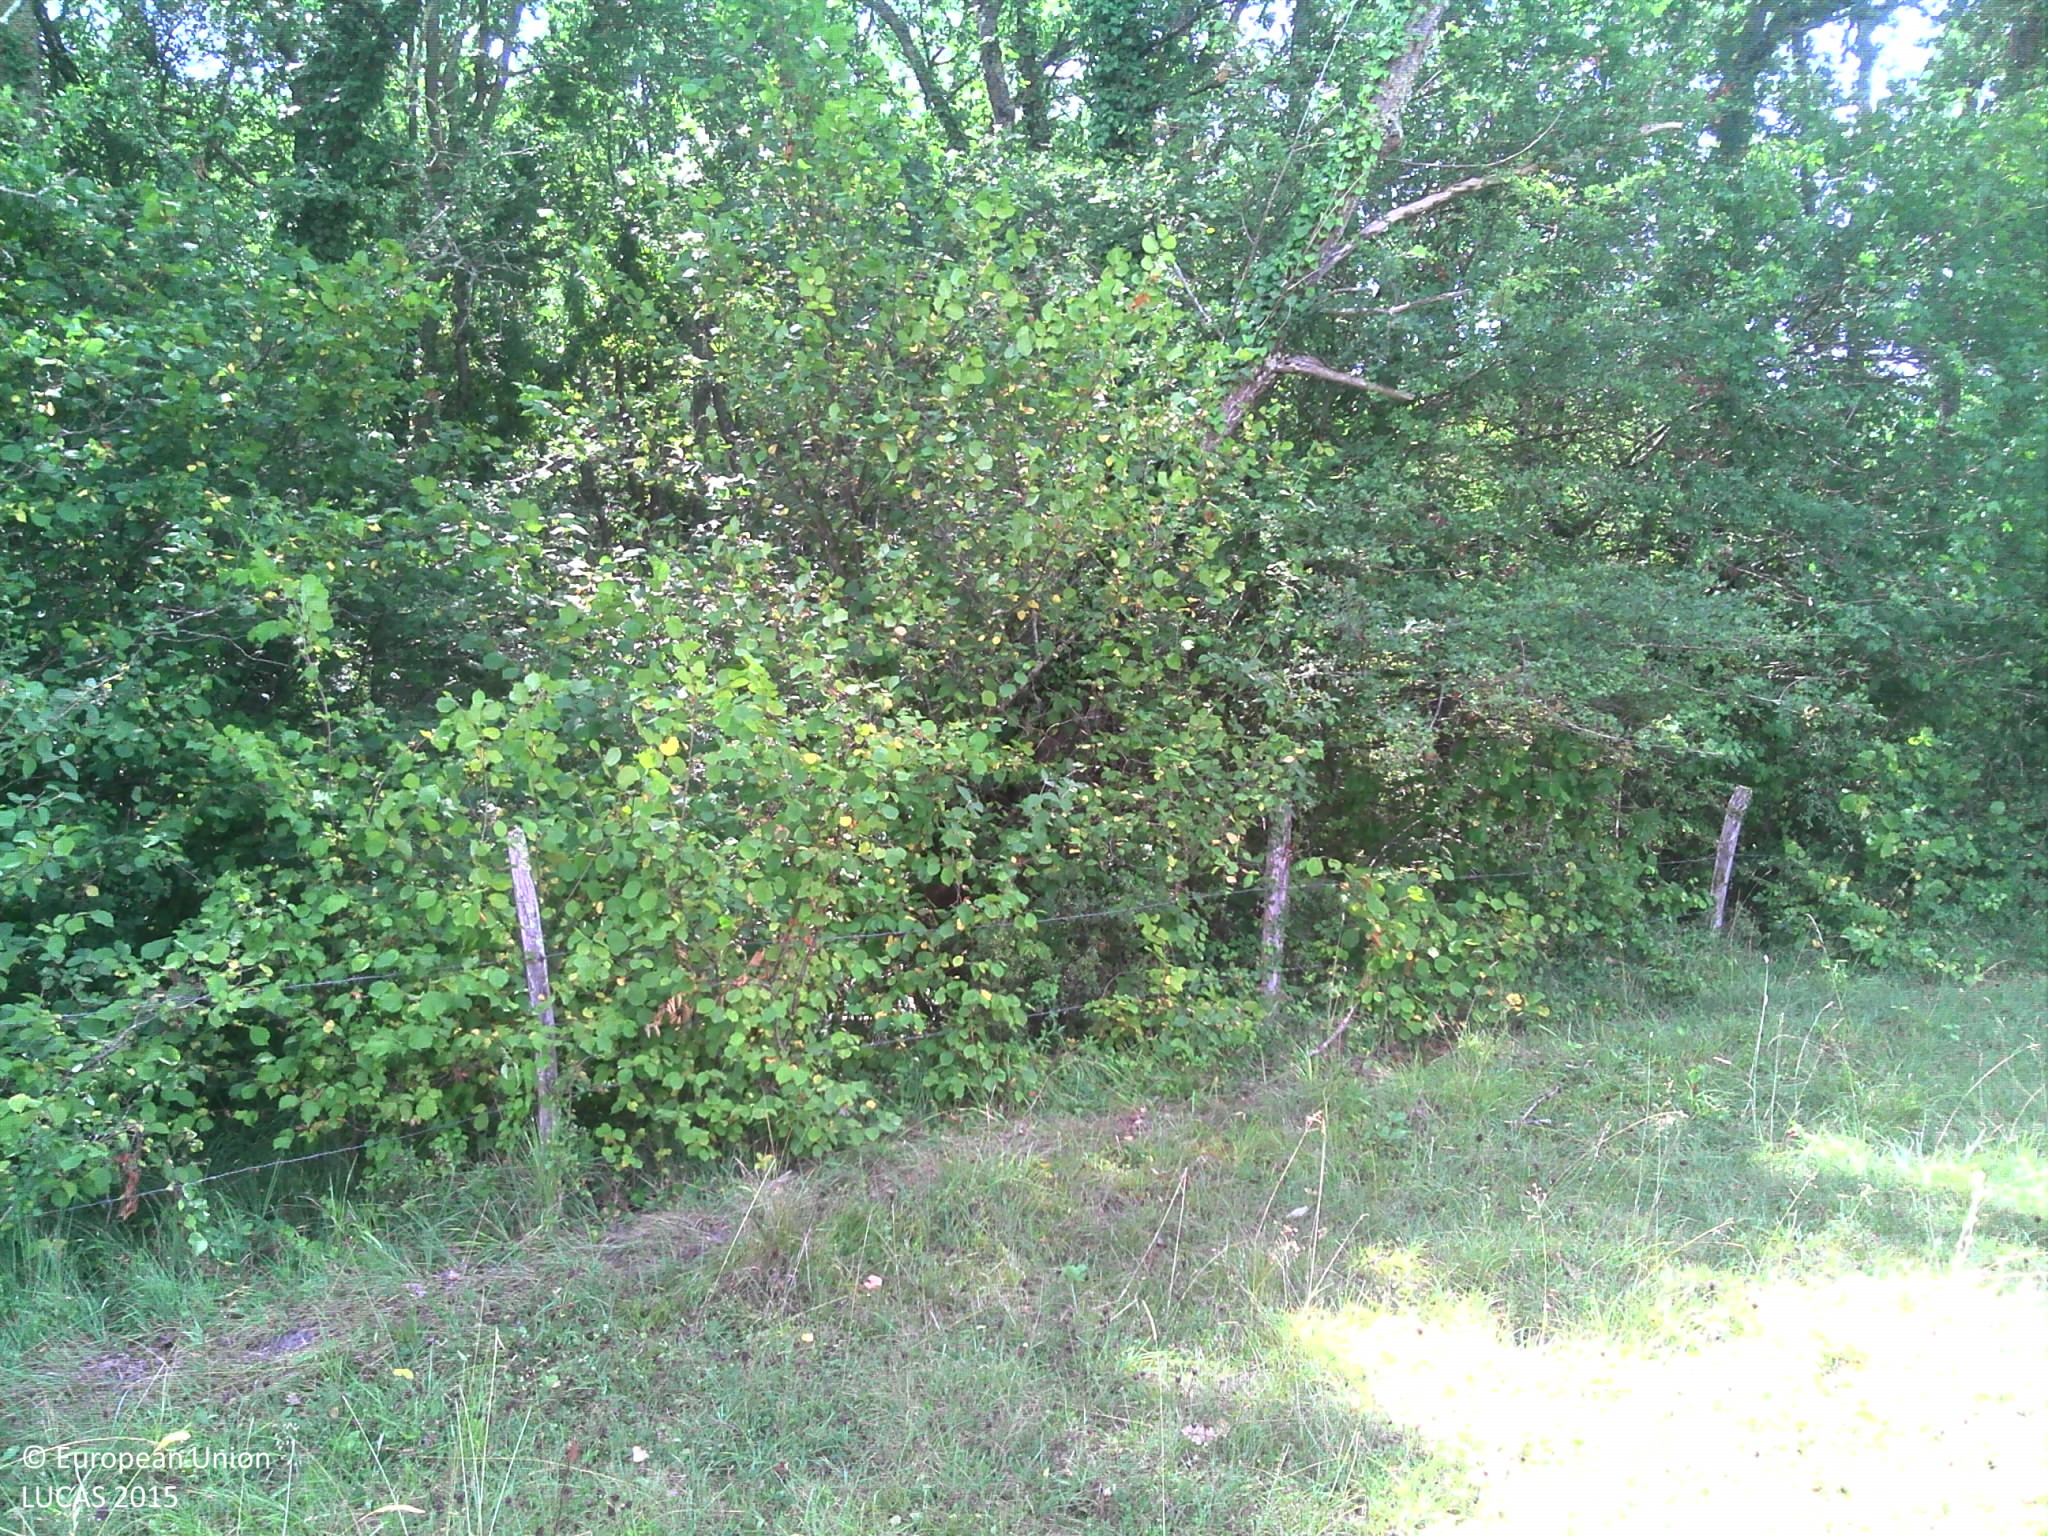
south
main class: Grassland
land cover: Grassland without tree/shrub cover
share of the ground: > 75 %
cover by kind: herbaceous plants 100 %
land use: Agriculture (excluding fallow land and kitchen gardens)
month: July
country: FR
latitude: 43.1664
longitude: 0.8634
